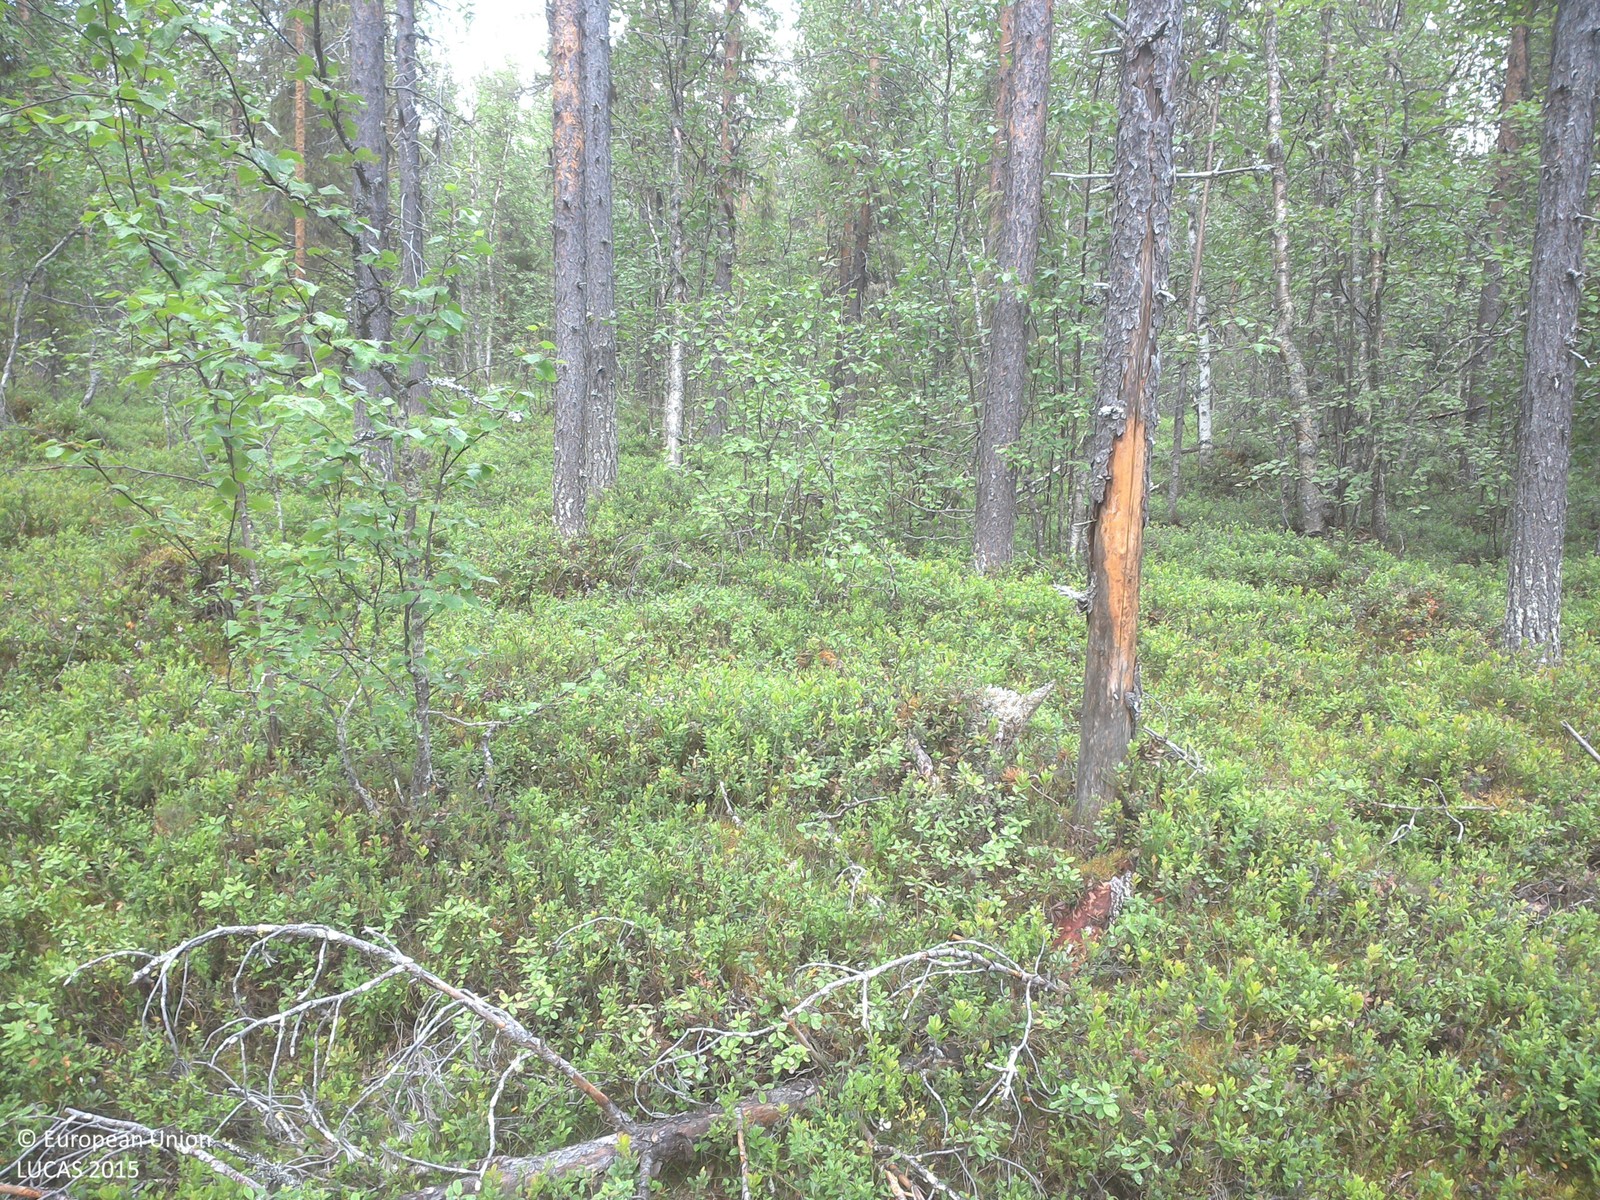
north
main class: Woodland
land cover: Pine dominated mixed woodland
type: boreal forest
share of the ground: 25 - 50 %
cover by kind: shrubs 55 %, coniferous forest trees 25 %, broadleaved forest trees 15 %, lichens and mosses 5 %
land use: Forestry
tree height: > 5 m
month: July
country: SE
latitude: 67.5909
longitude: 23.5313
